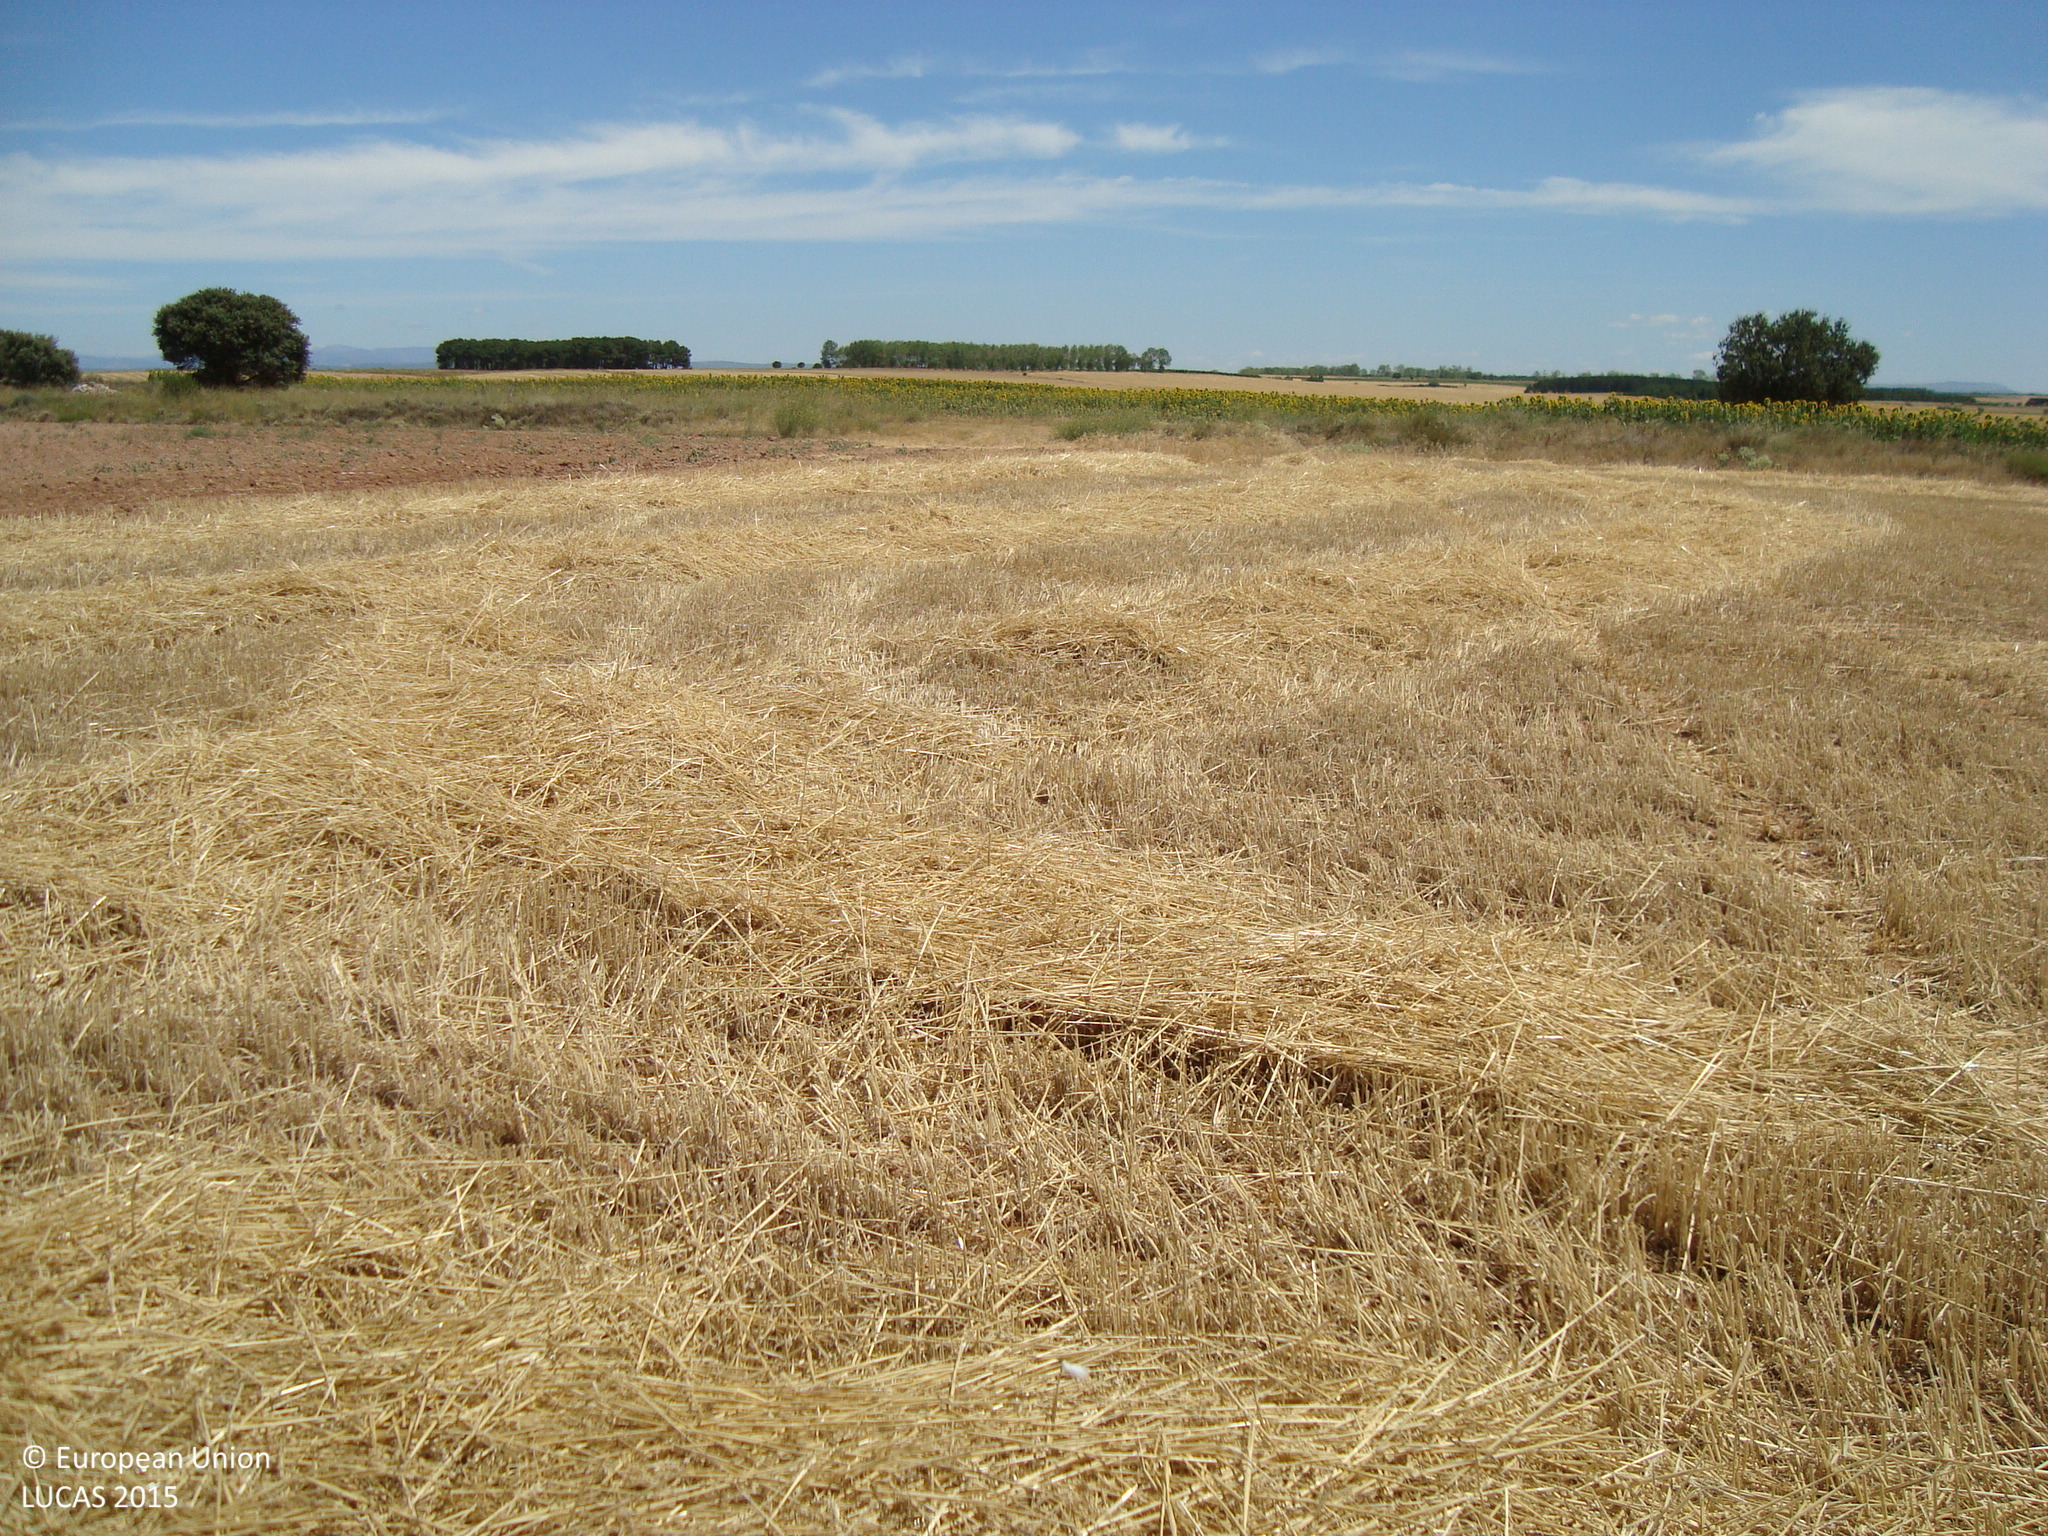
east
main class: Cropland
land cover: Common wheat
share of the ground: > 75 %
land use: Agriculture (excluding fallow land and kitchen gardens)
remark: Harvested field
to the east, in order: Common wheat; Grassland with sparse tree/shrub cover; Tracks; Sunflower
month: July
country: ES
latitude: 42.0990
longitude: -3.8567
